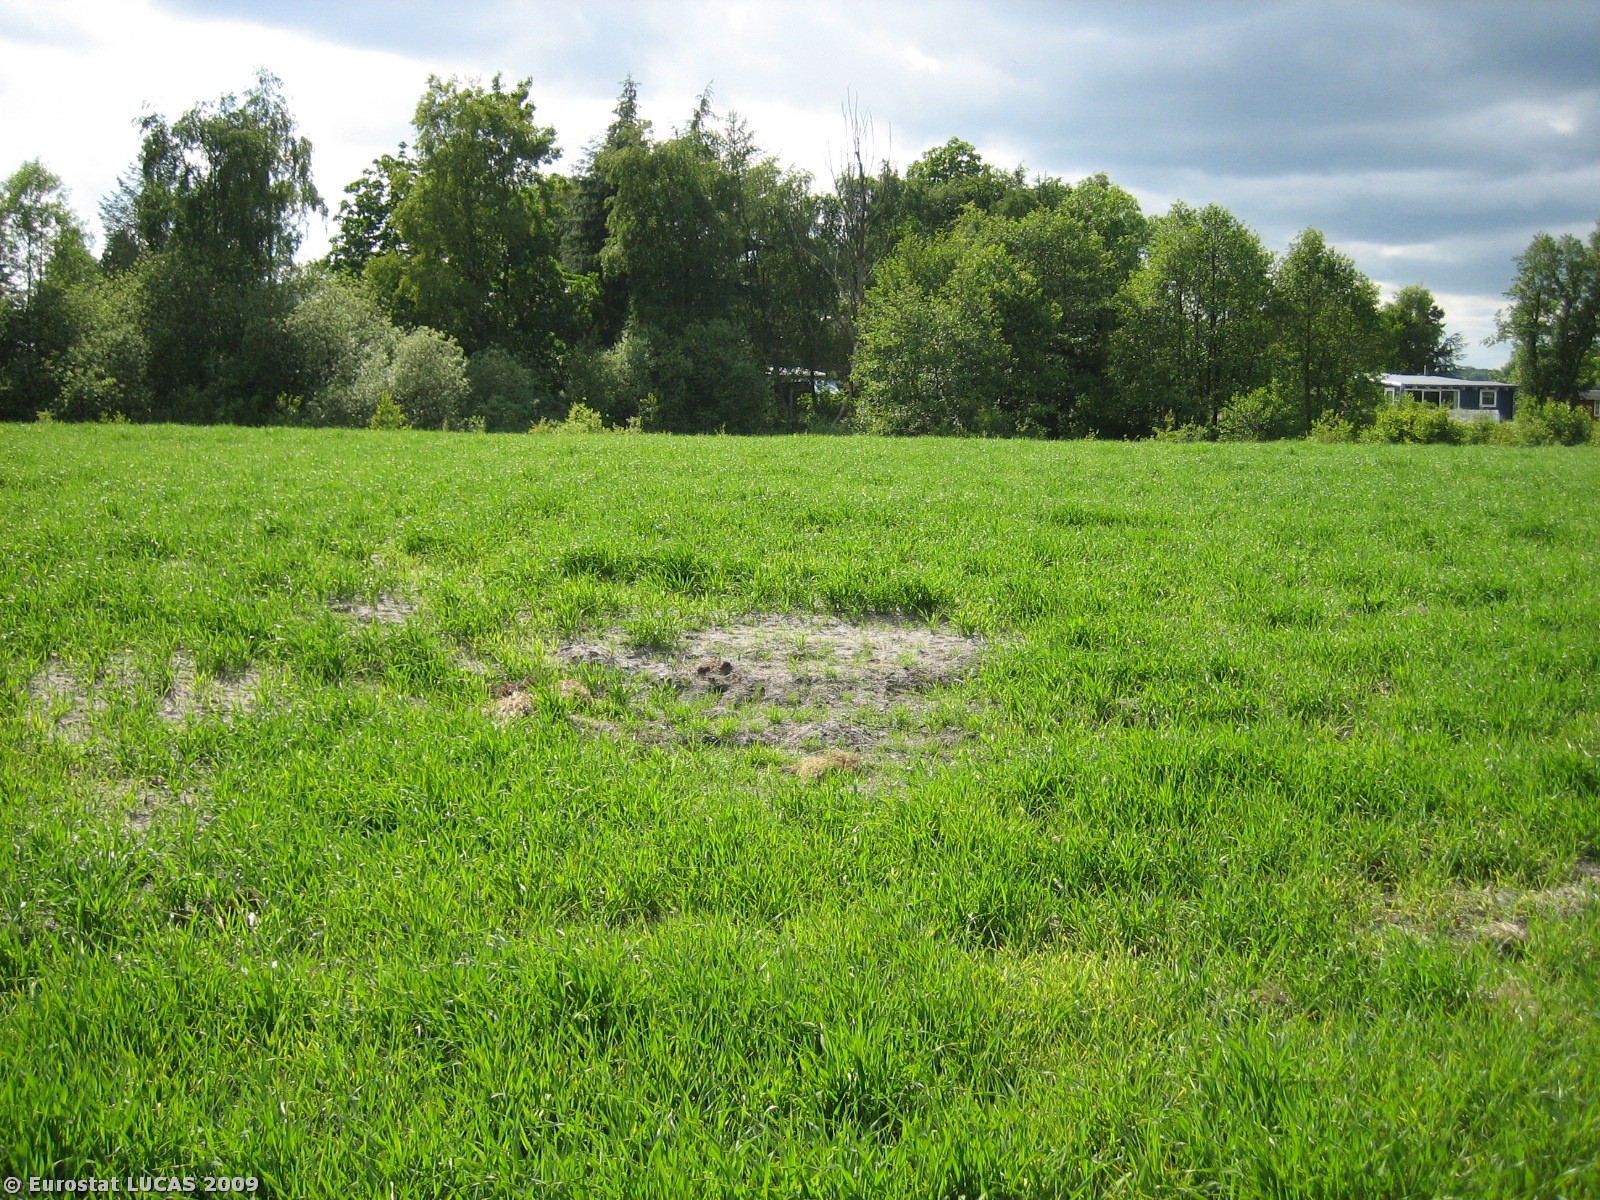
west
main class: Cropland
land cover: Barley
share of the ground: > 75 %
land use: Agriculture (excluding fallow land and kitchen gardens)
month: June
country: DK
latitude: 56.0438
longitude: 9.8557
